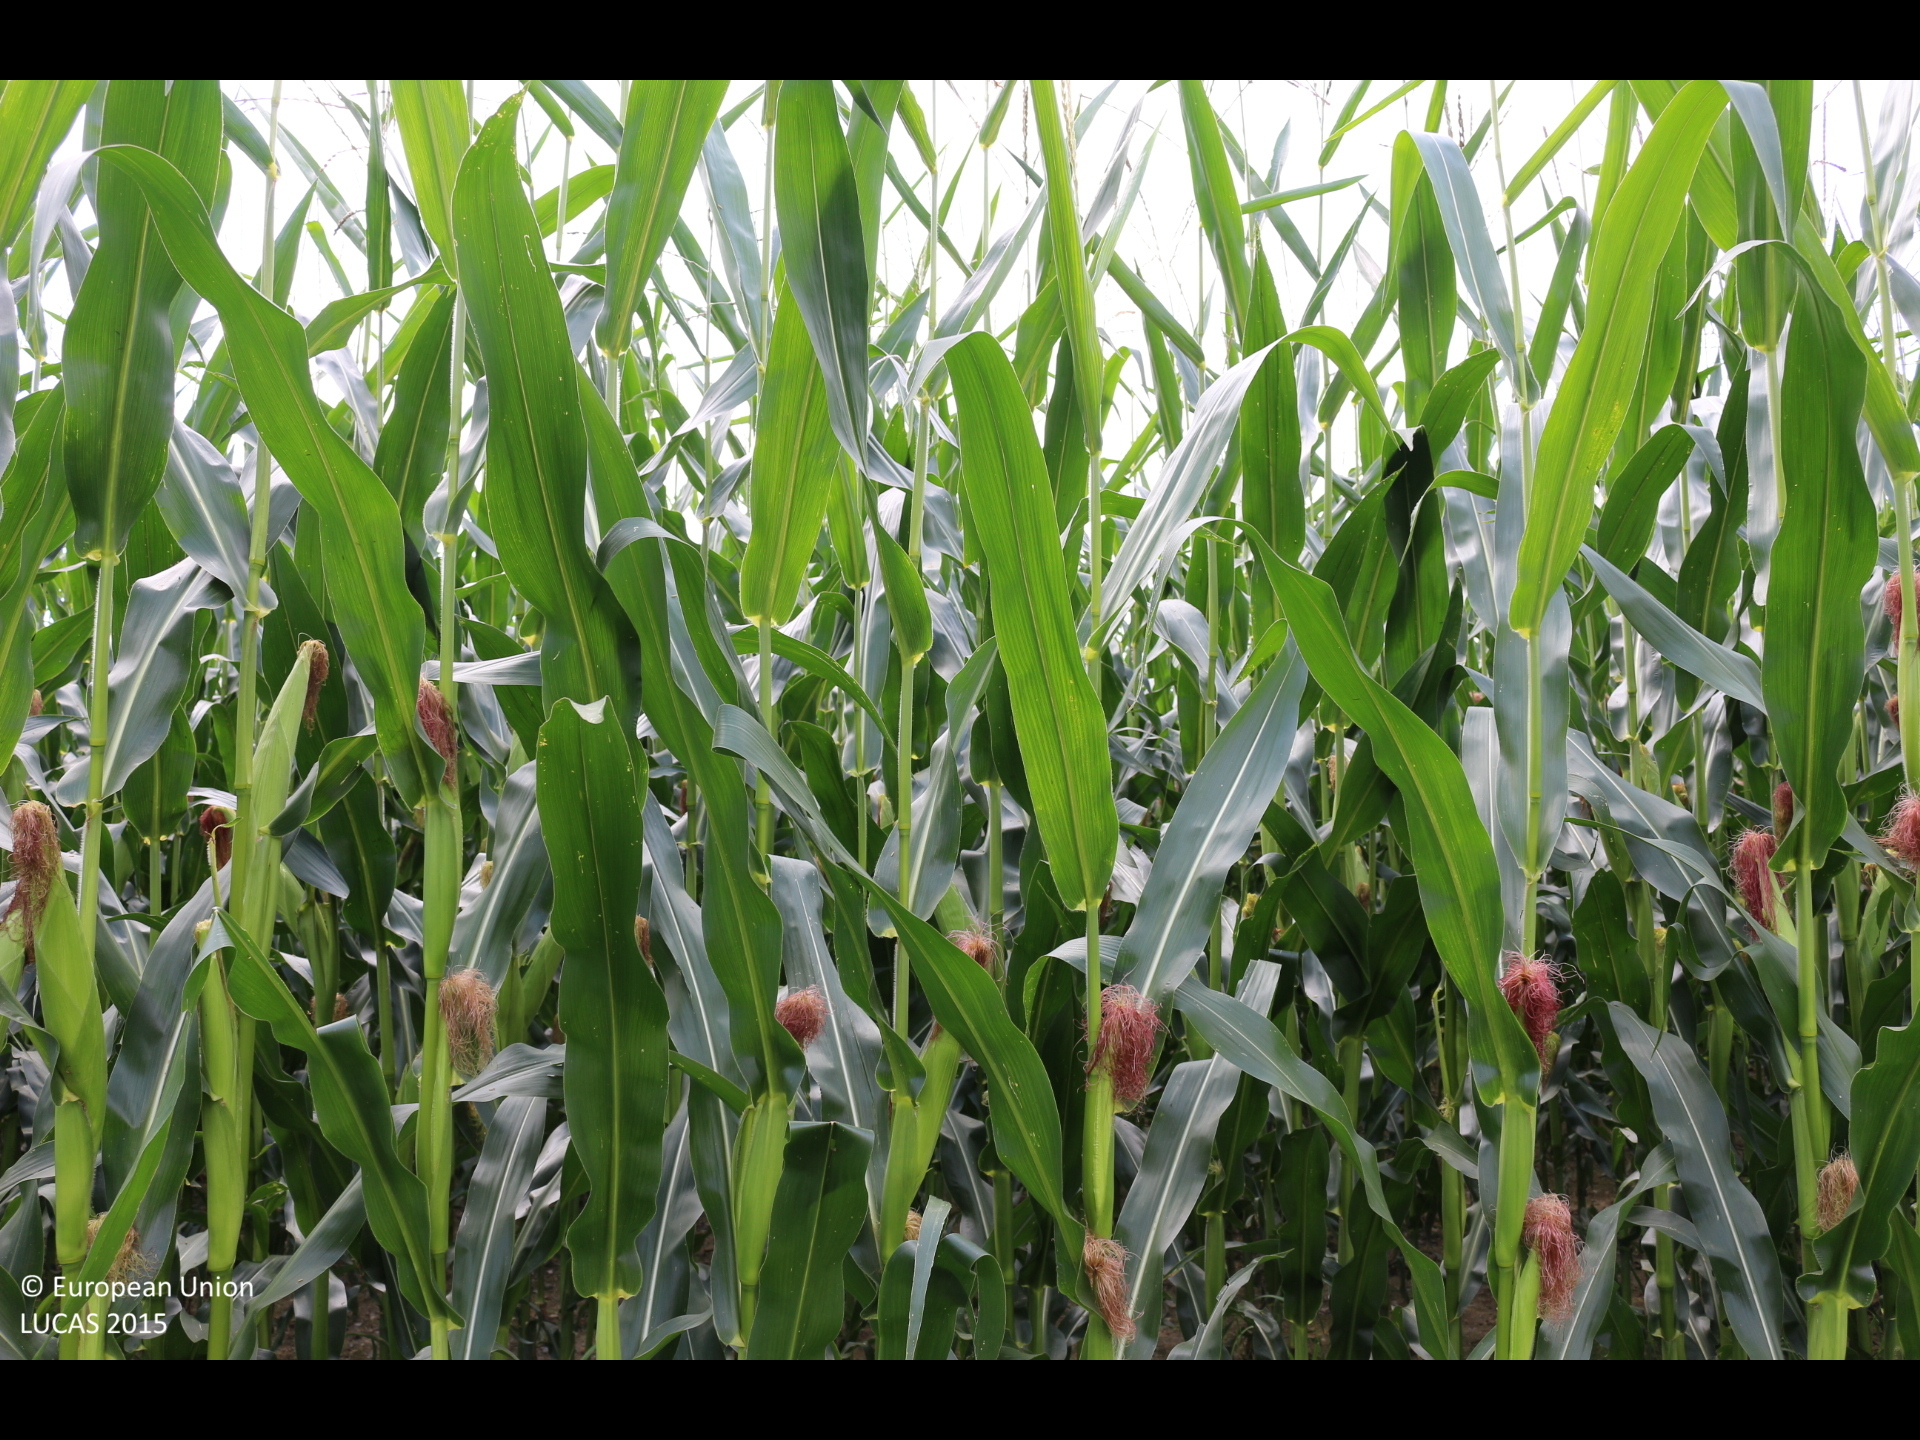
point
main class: Cropland
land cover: Maize
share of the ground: > 75 %
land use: Agriculture (excluding fallow land and kitchen gardens)
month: August
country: AT
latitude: 46.8665
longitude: 14.1301
